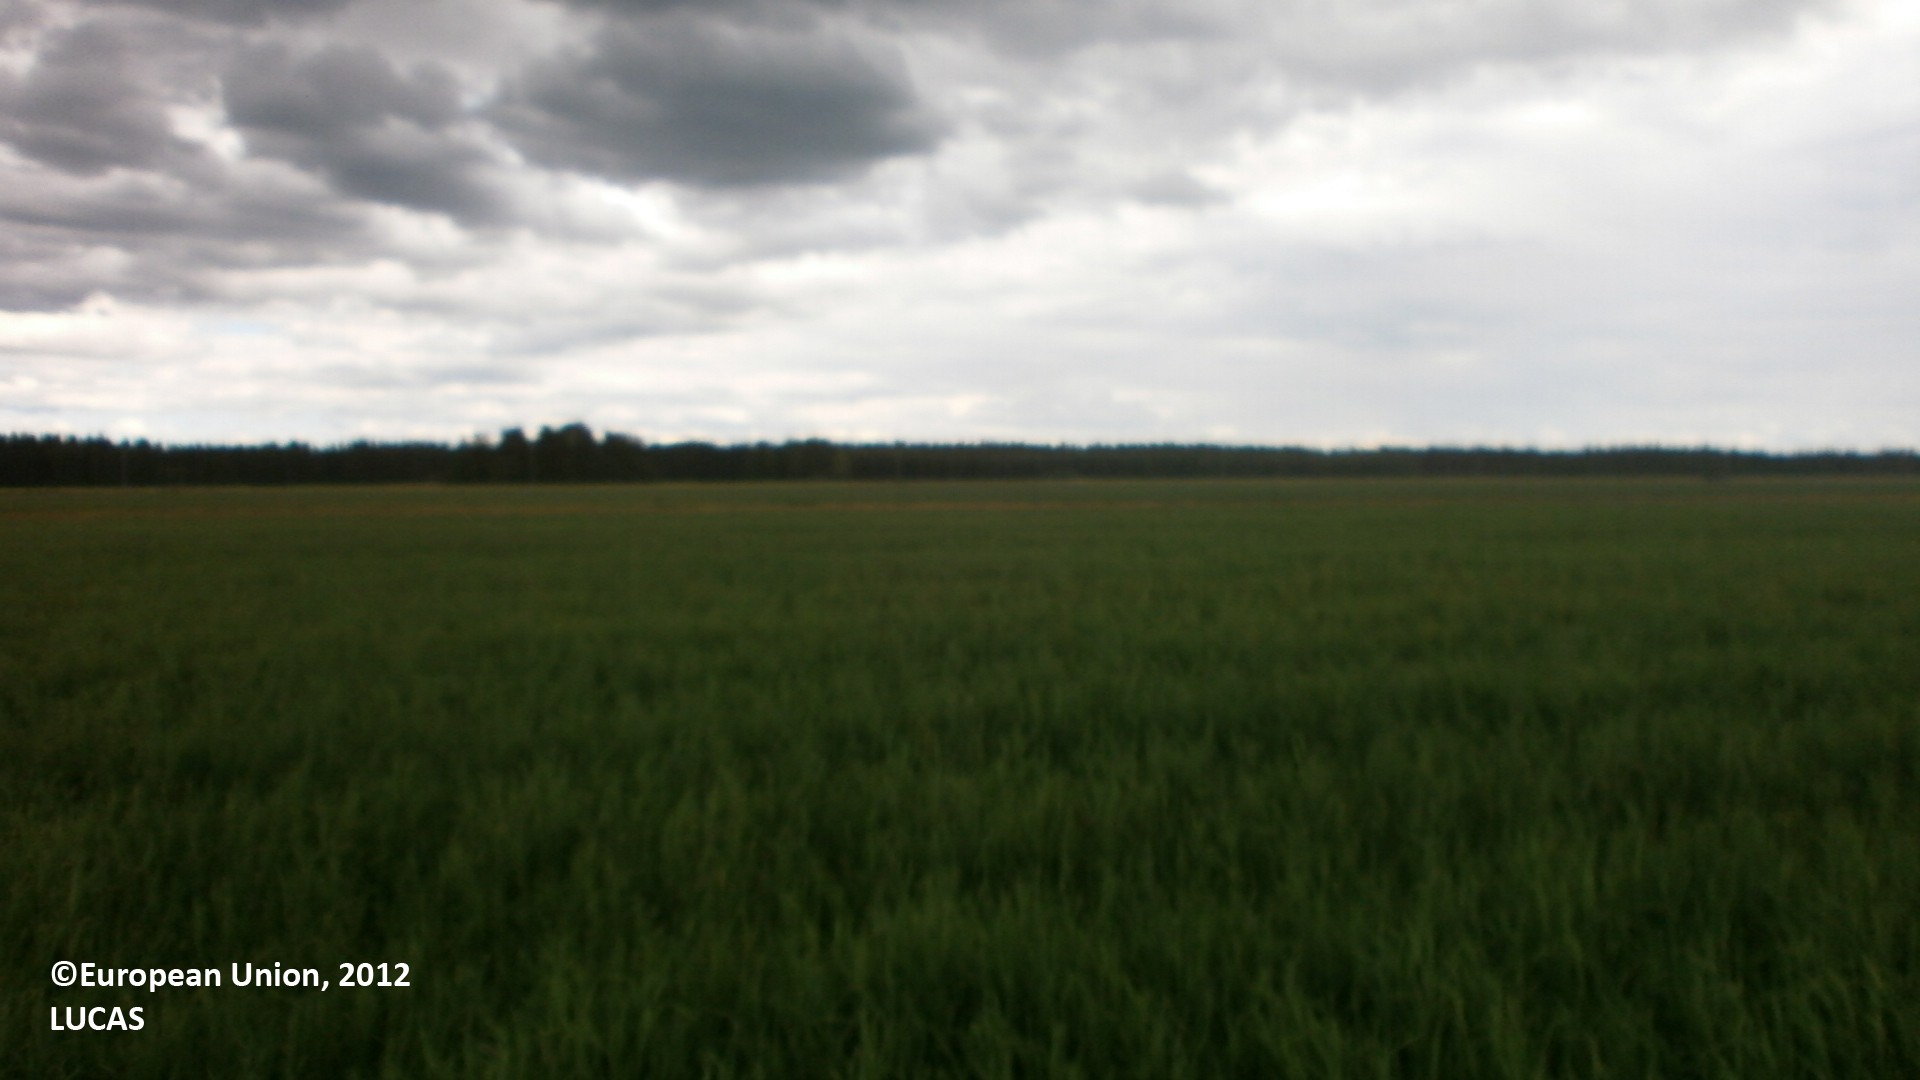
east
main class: Cropland
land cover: Temporary grasslands
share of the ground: > 75 %
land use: Agriculture (excluding fallow land and kitchen gardens)
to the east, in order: Temporary grasslands; Ditches and canals; Shruby margins; Tracks; Shruby margins; Ditches and canals; Shruby margins; Temporary grasslands; Fences; Temporary grasslands; Fences; Temporary grasslands; Shruby margins; Electric lines; Ditches and canals; Shruby margins; Barley
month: July
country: FI
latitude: 64.1785
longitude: 24.2036
